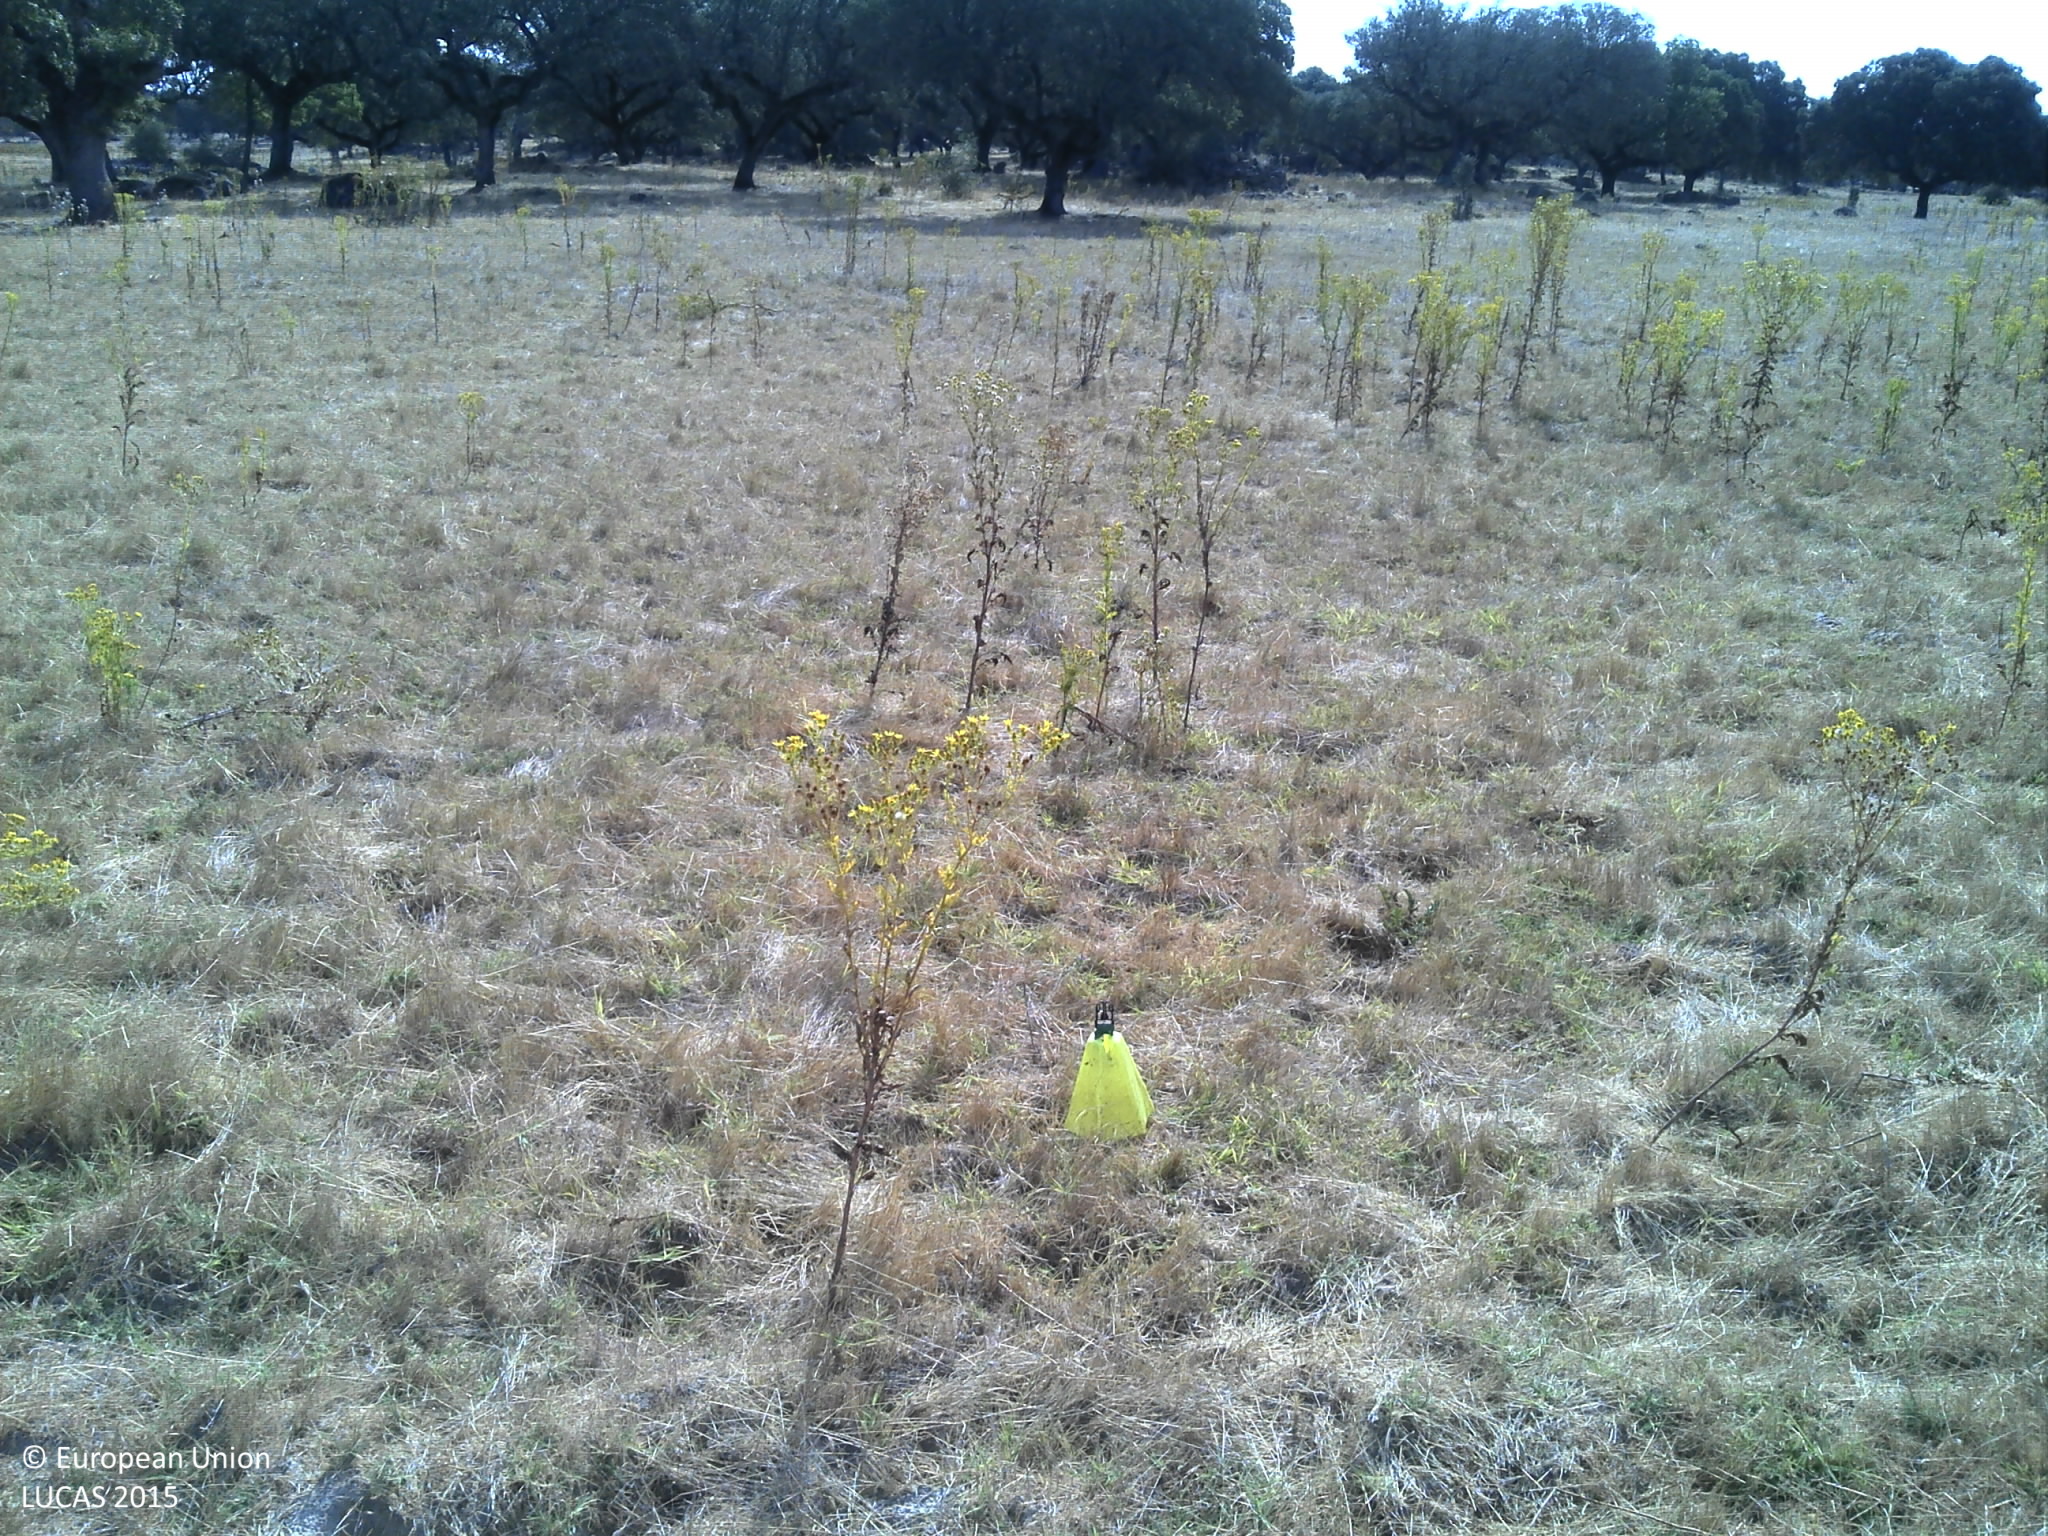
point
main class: Grassland
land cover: Grassland without tree/shrub cover
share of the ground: 50 - 75 %
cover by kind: herbaceous plants 60 %, unconsolidated bare surface 40 %
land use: Agriculture (excluding fallow land and kitchen gardens)
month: August
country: PT
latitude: 39.2964
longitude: -7.5651
